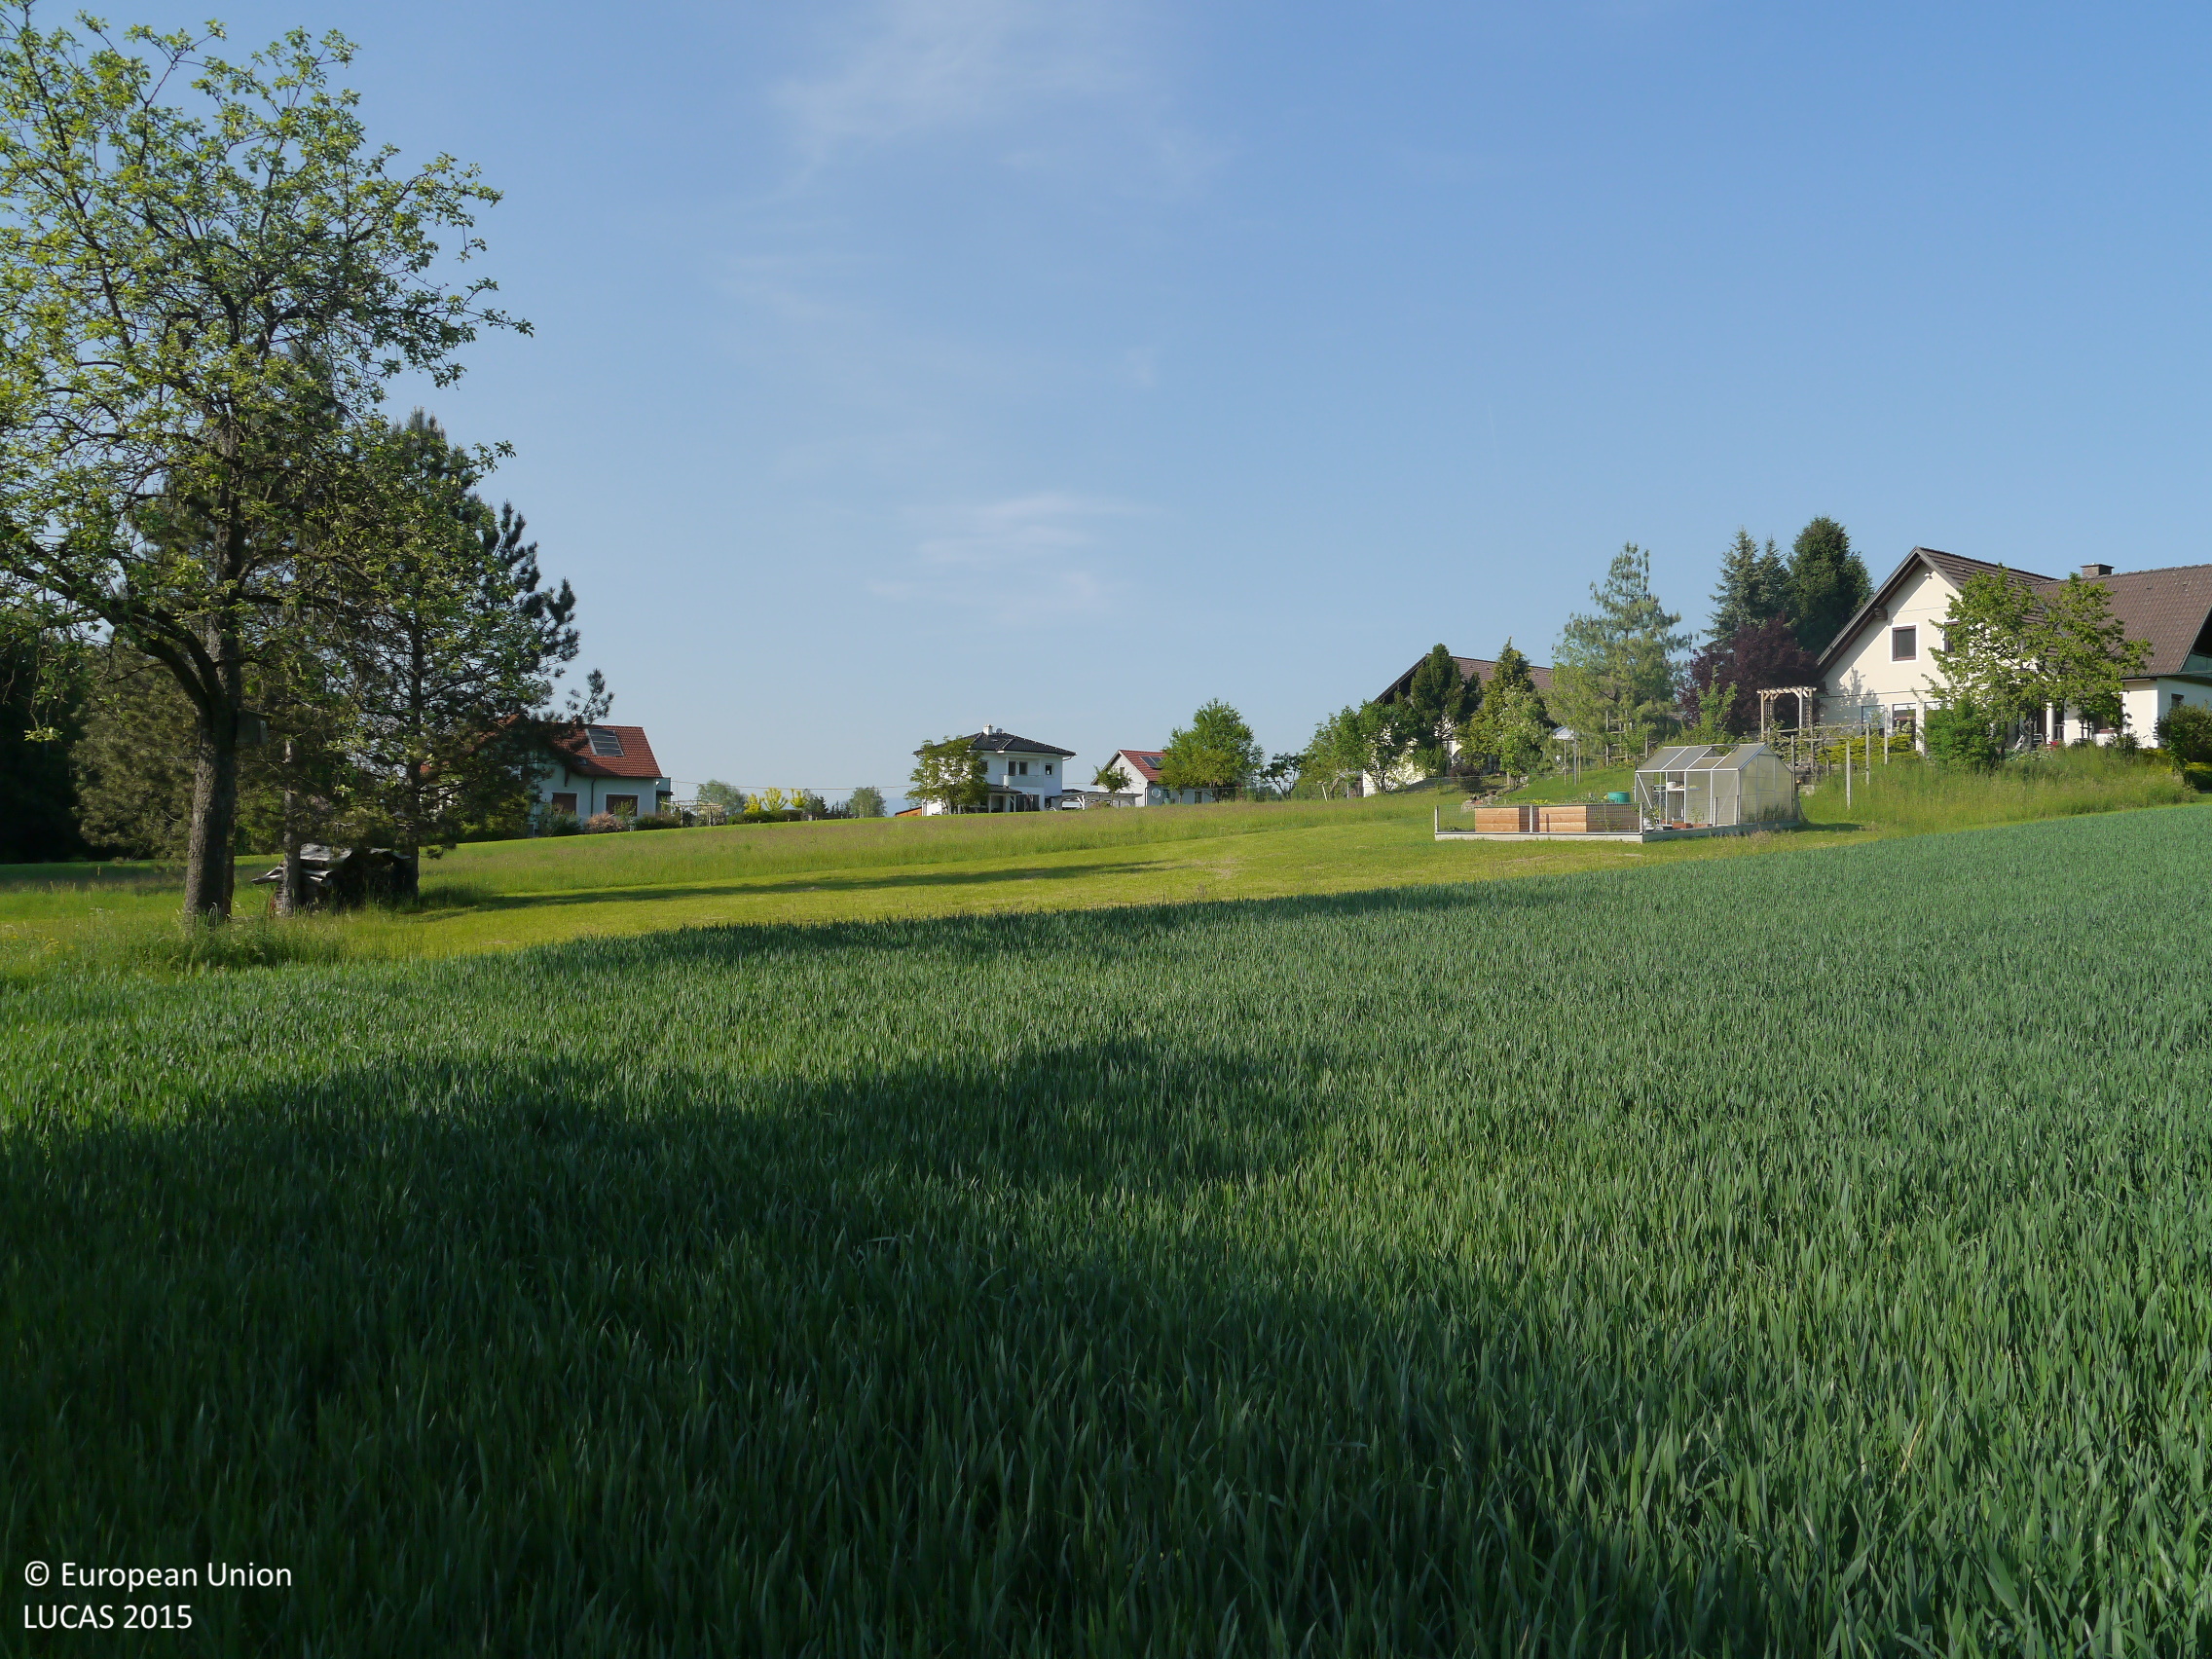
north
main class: Cropland
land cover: Common wheat
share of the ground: > 75 %
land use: Agriculture (excluding fallow land and kitchen gardens)
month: May
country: AT
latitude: 46.9548
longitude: 15.4001
